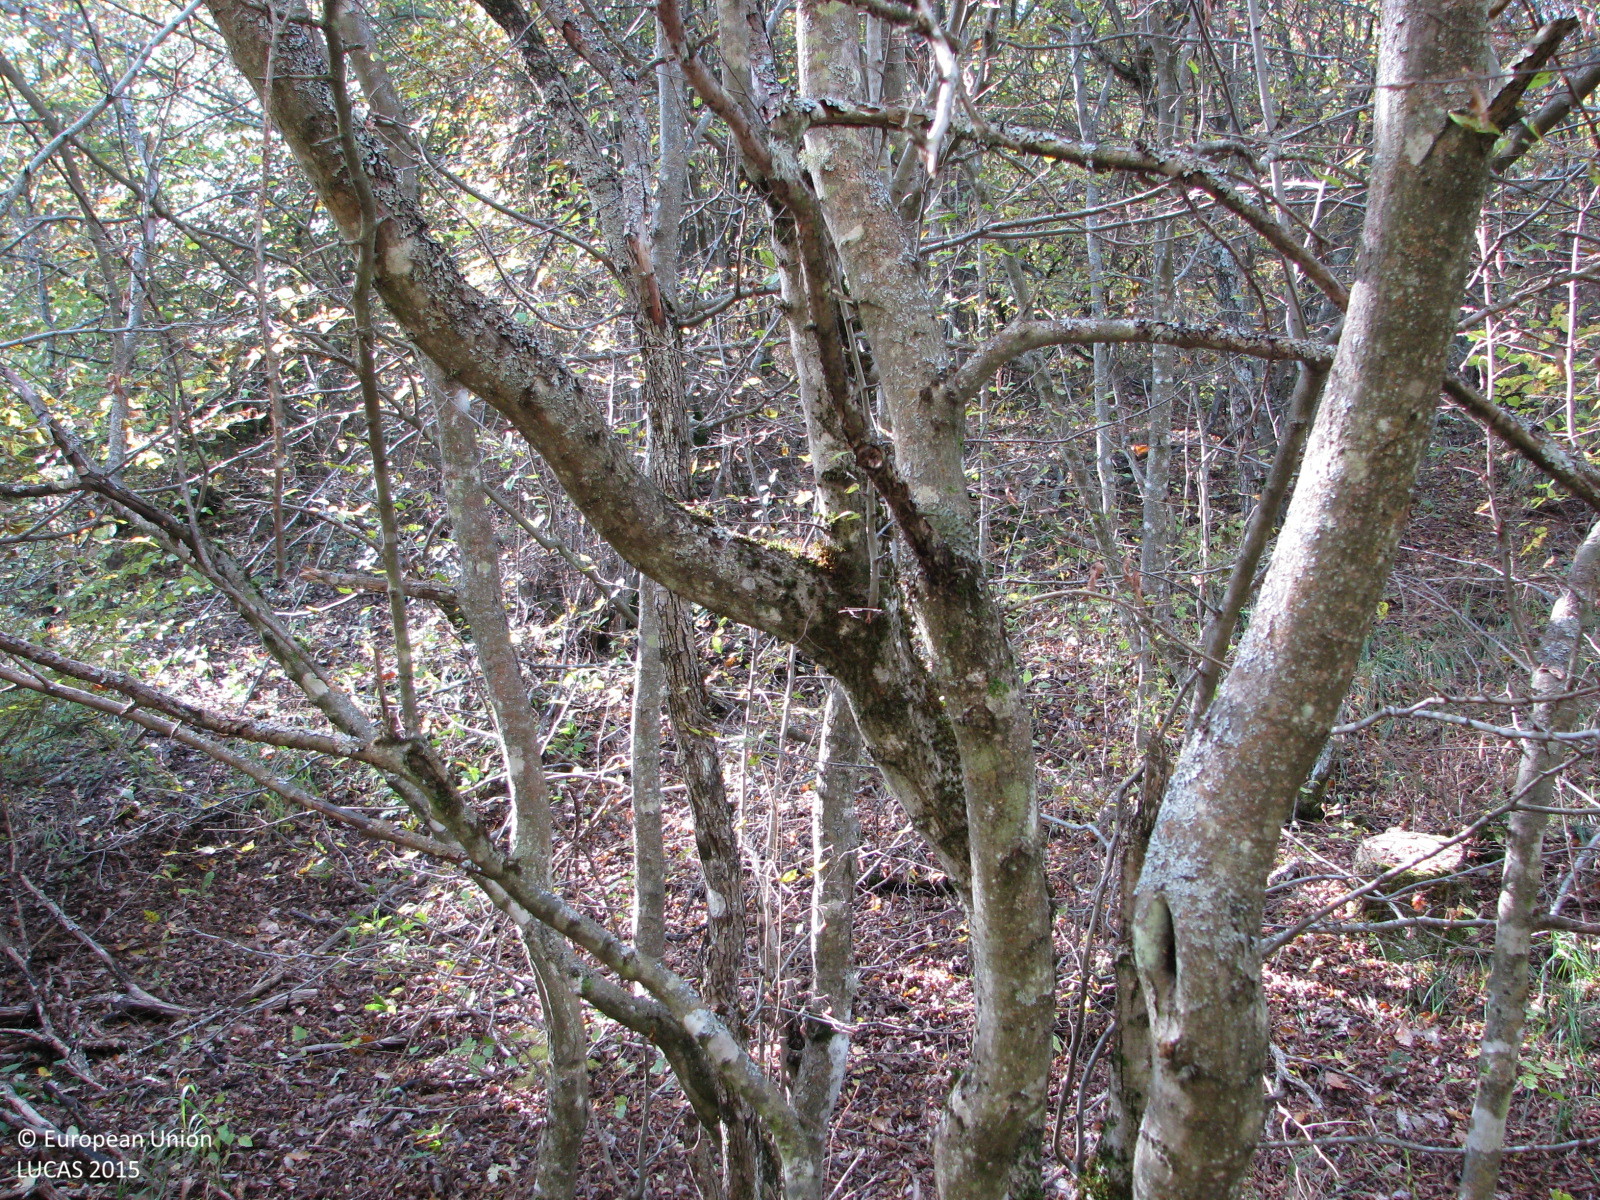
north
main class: Woodland
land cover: Broadleaved woodland
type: mesophytic deciduous forest
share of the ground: > 75 %
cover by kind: broadleaved forest trees 80 %, shrubs 10 %, herbaceous plants 10 %
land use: Semi-natural and natural areas not in use
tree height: > 5 m
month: October
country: BG
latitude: 42.3198
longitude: 26.8304
